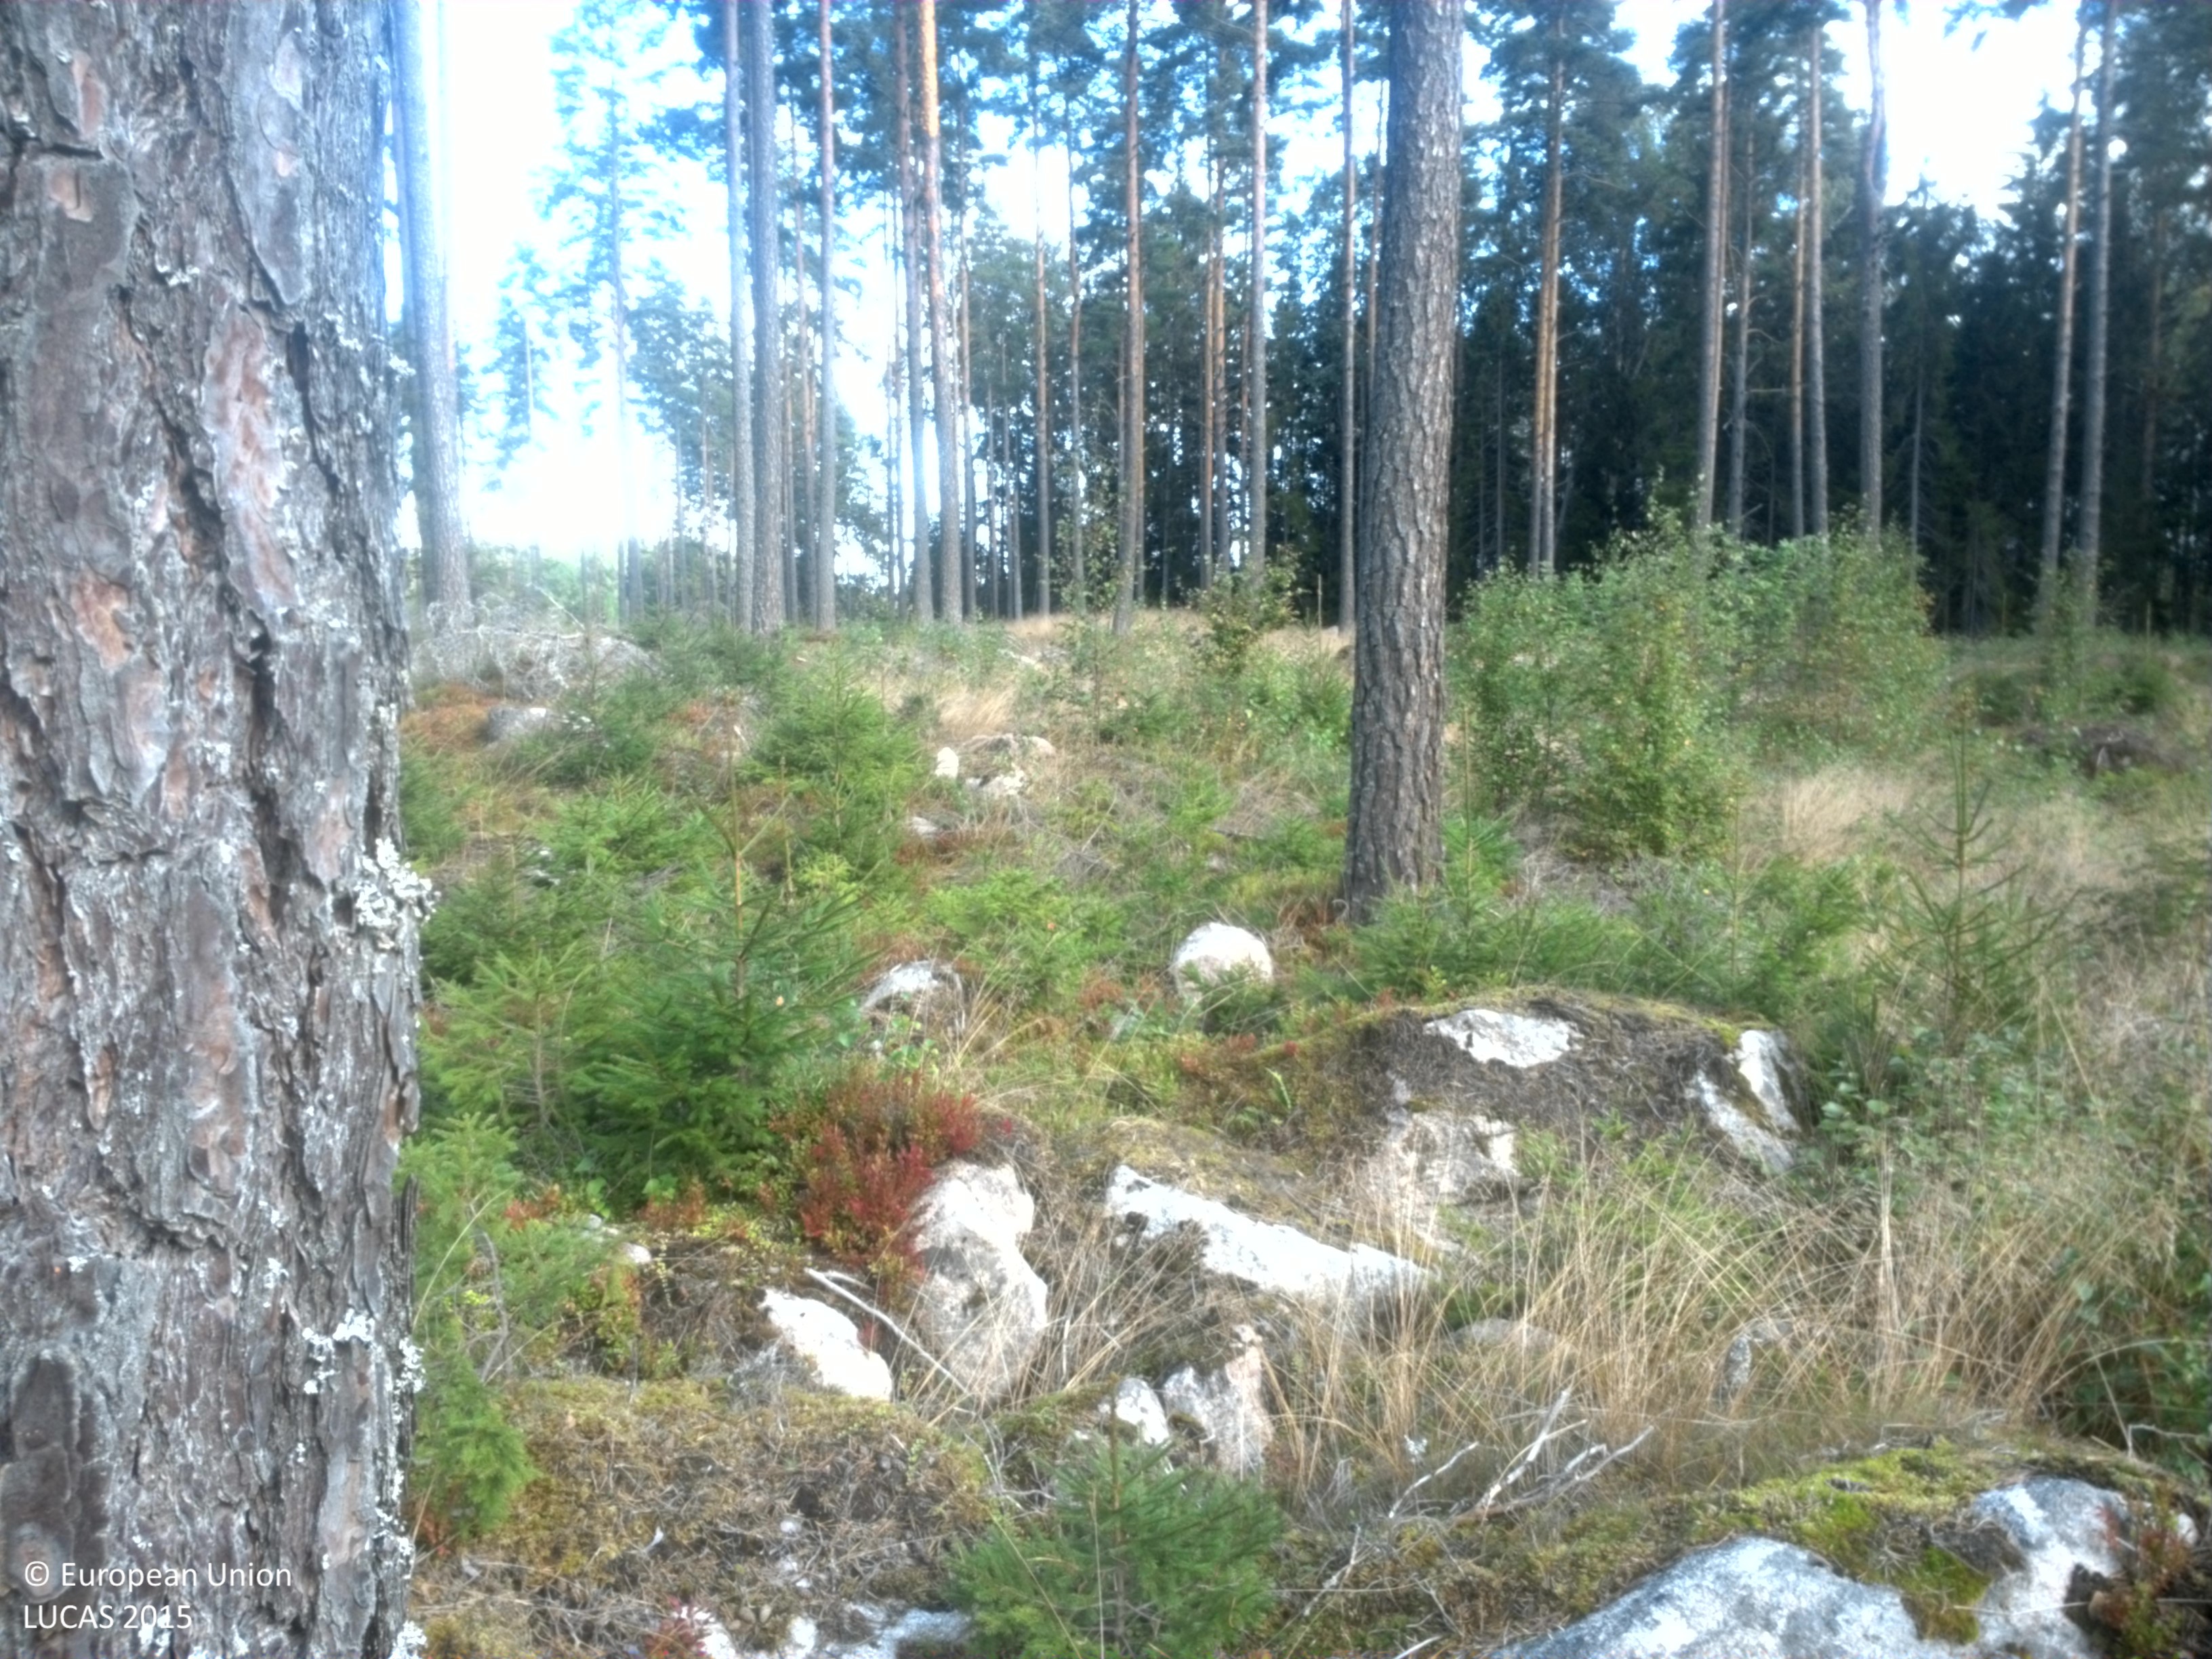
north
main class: Woodland
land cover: Pine dominated coniferous woodland
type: boreal forest
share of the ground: 50 - 75 %
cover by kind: coniferous forest trees 50 %, shrubs 25 %, herbaceous plants 15 %, broadleaved forest trees 5 %, lichens and mosses 5 %
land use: Forestry
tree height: > 5 m
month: September
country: SE
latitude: 59.5433
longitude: 15.6686
